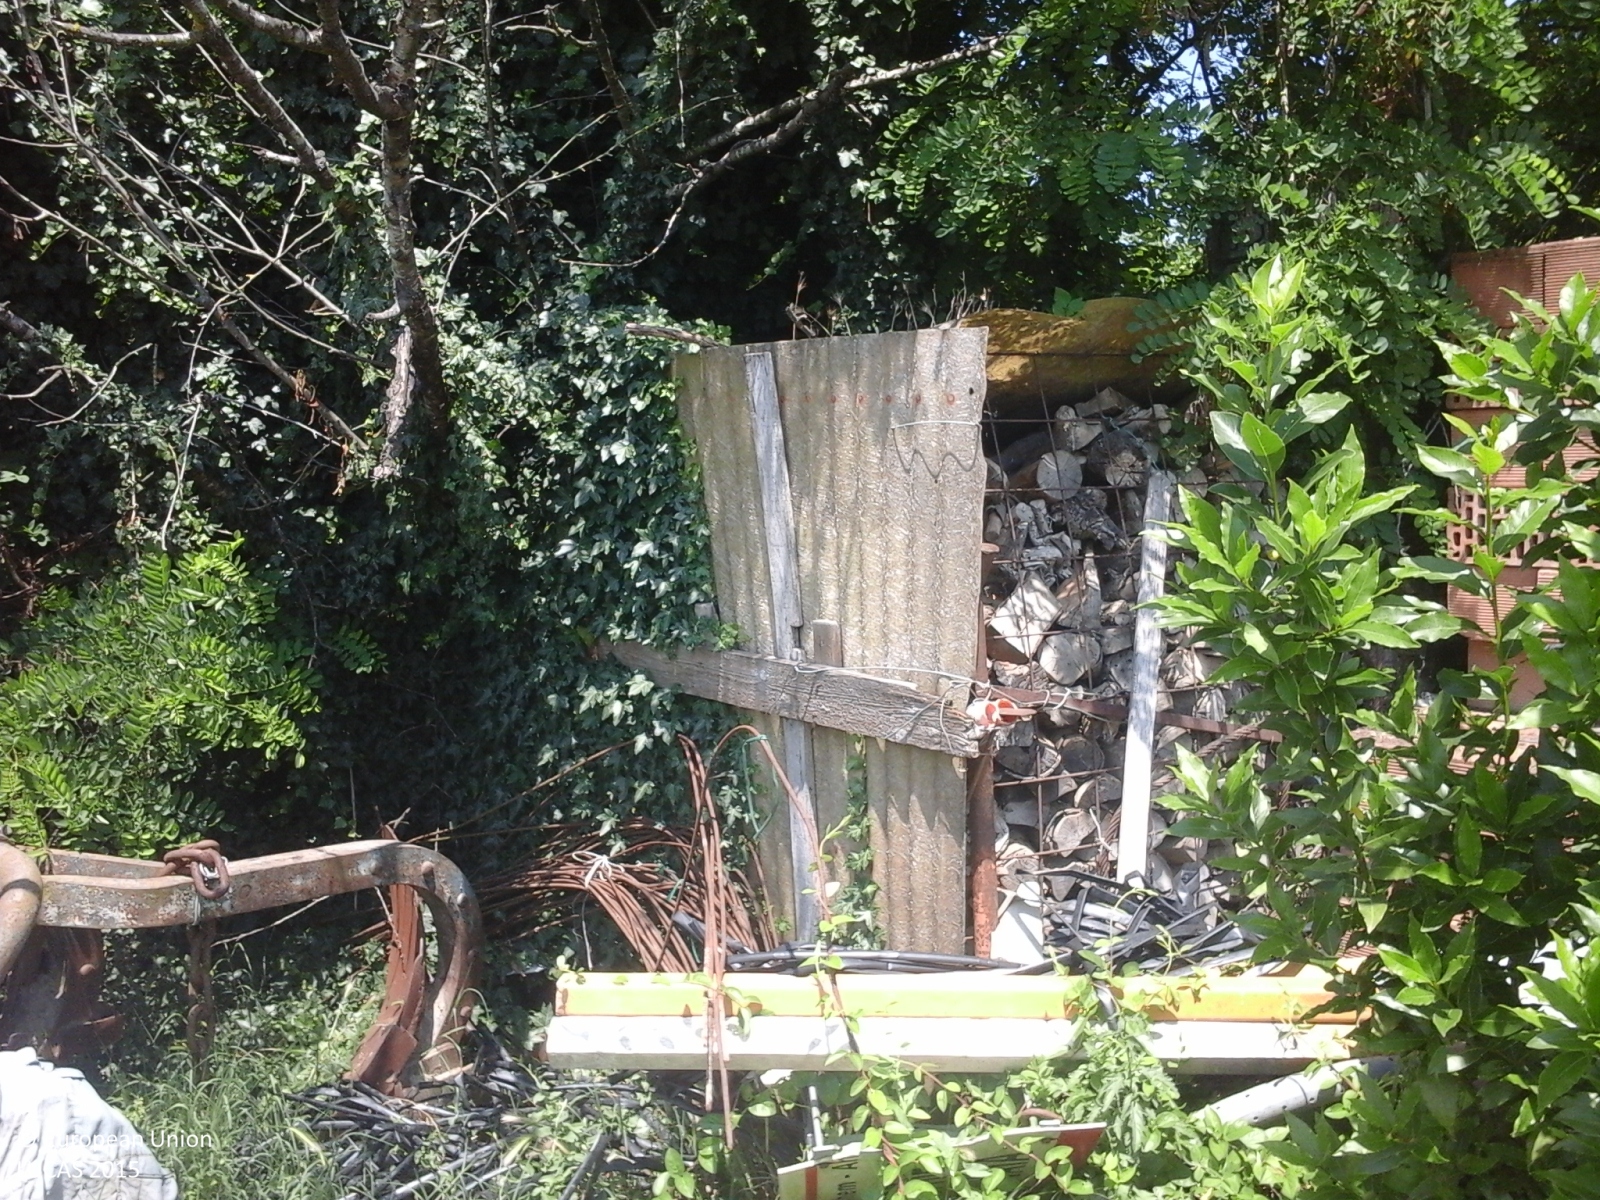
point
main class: Woodland
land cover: Broadleaved woodland
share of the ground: > 75 %
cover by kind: broadleaved forest trees 100 %
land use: Residential
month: June
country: IT
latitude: 44.6033
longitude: 11.9237
